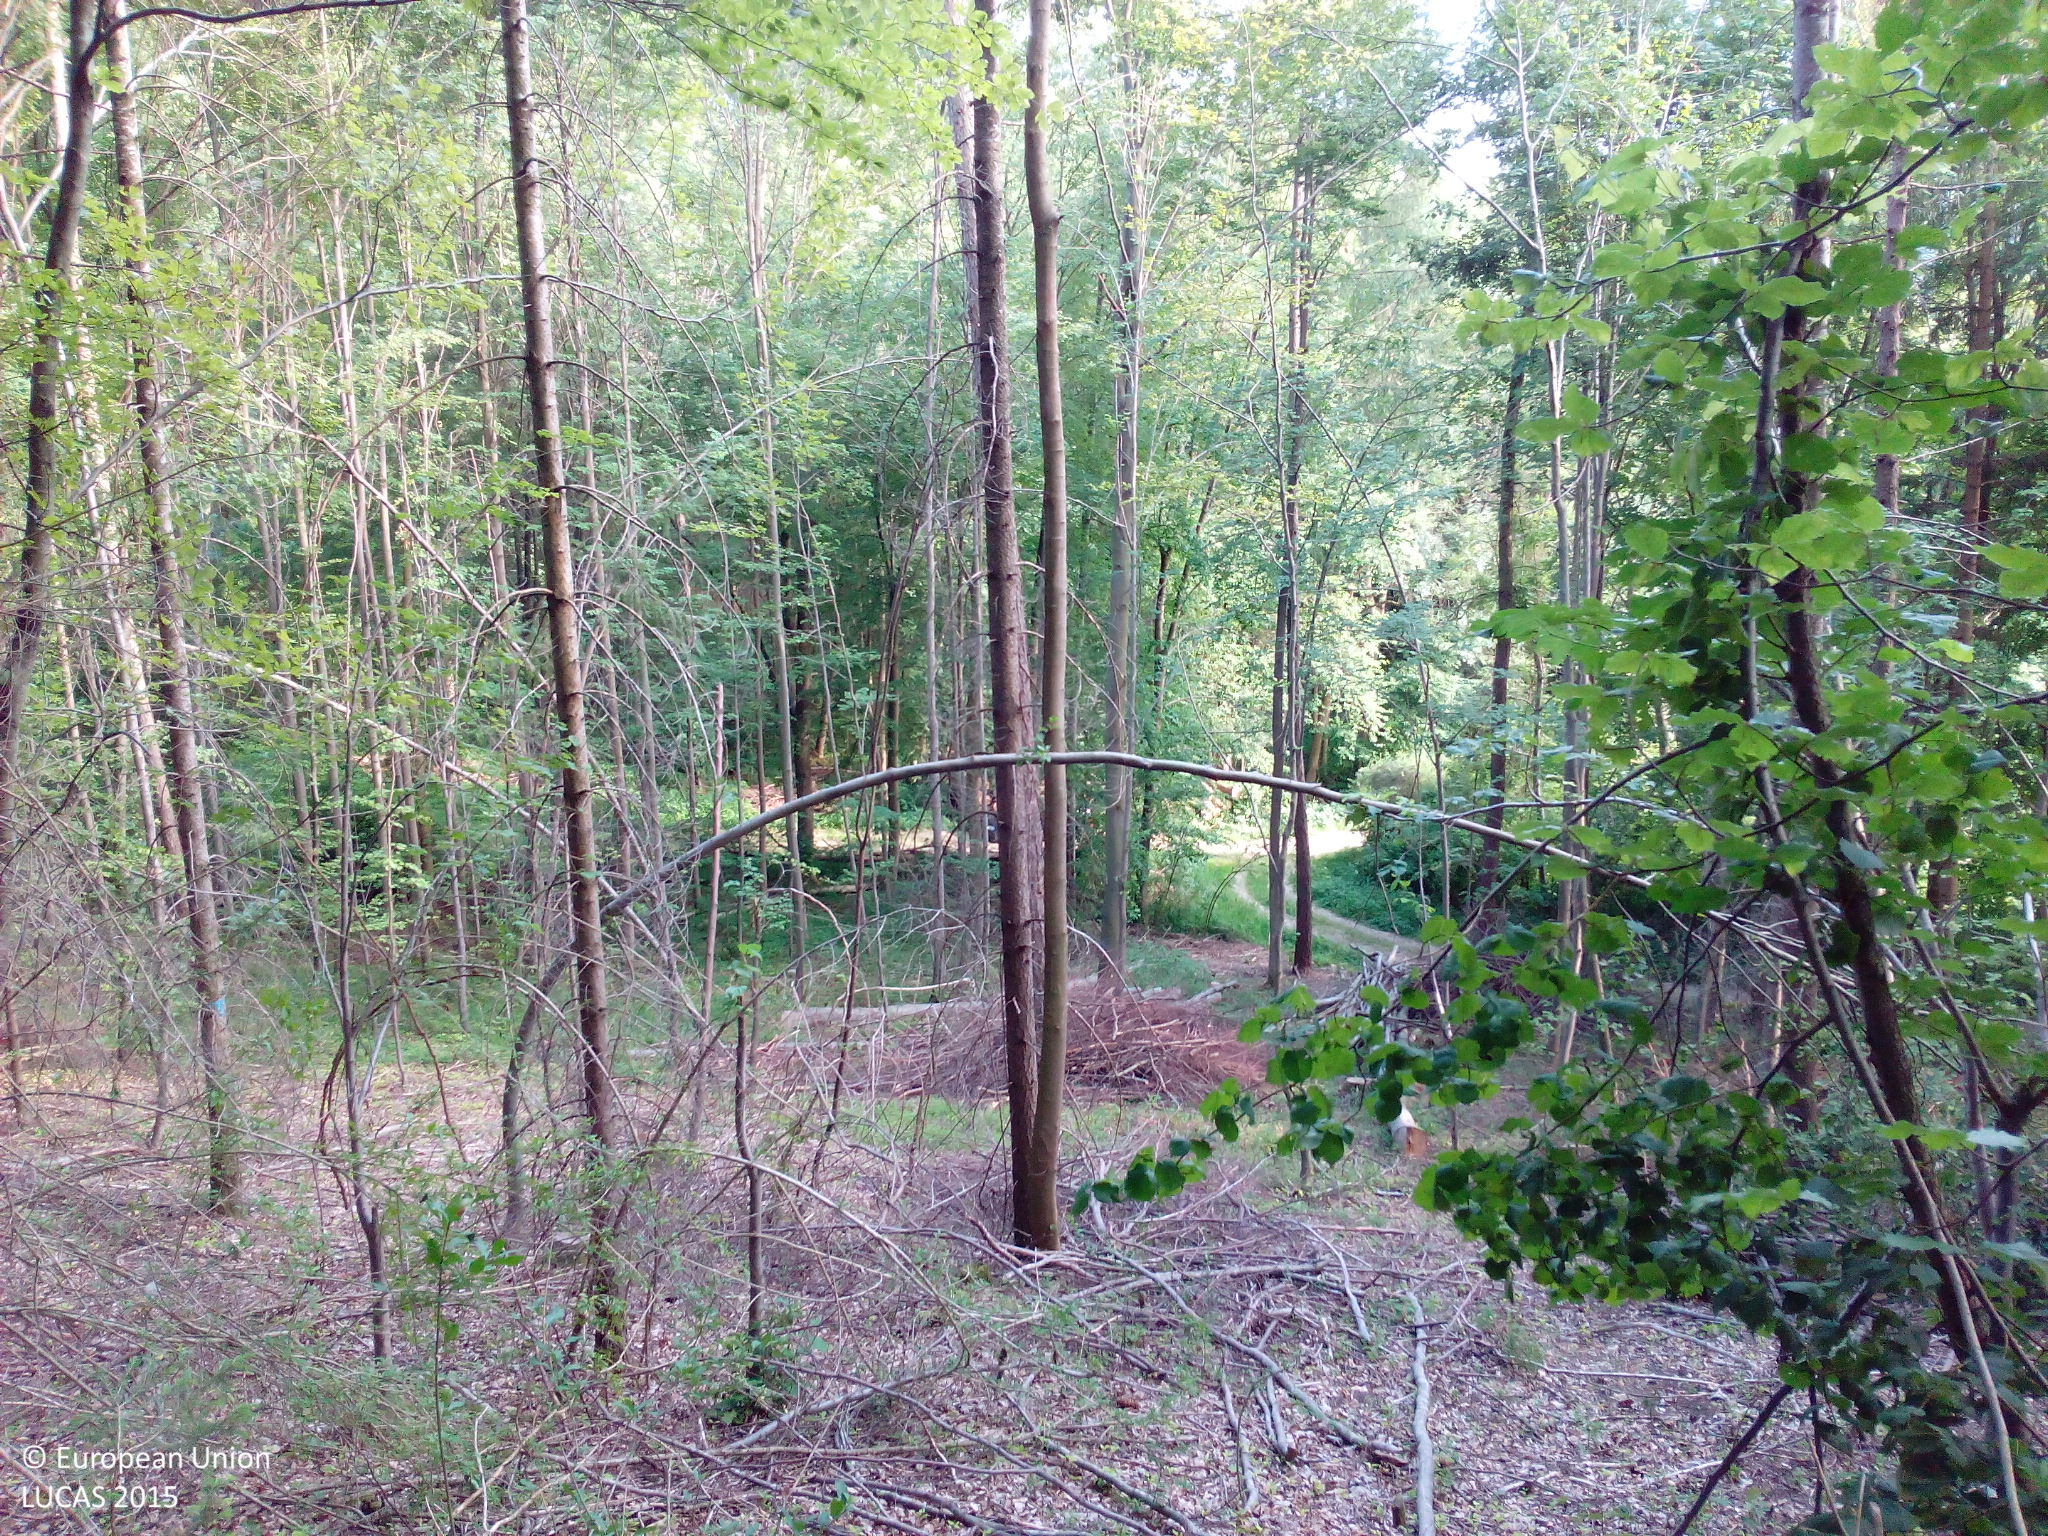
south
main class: Woodland
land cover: Spruce dominated mixed woodland
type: hemiboreal forest and nemoral coniferous forest and mixed broadleaved-coniferous forest
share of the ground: > 75 %
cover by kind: broadleaved forest trees 65 %, coniferous forest trees 25 %, unconsolidated bare surface 10 %
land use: Forestry
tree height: > 5 m
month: July
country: DE
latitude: 48.6010
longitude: 9.6883
